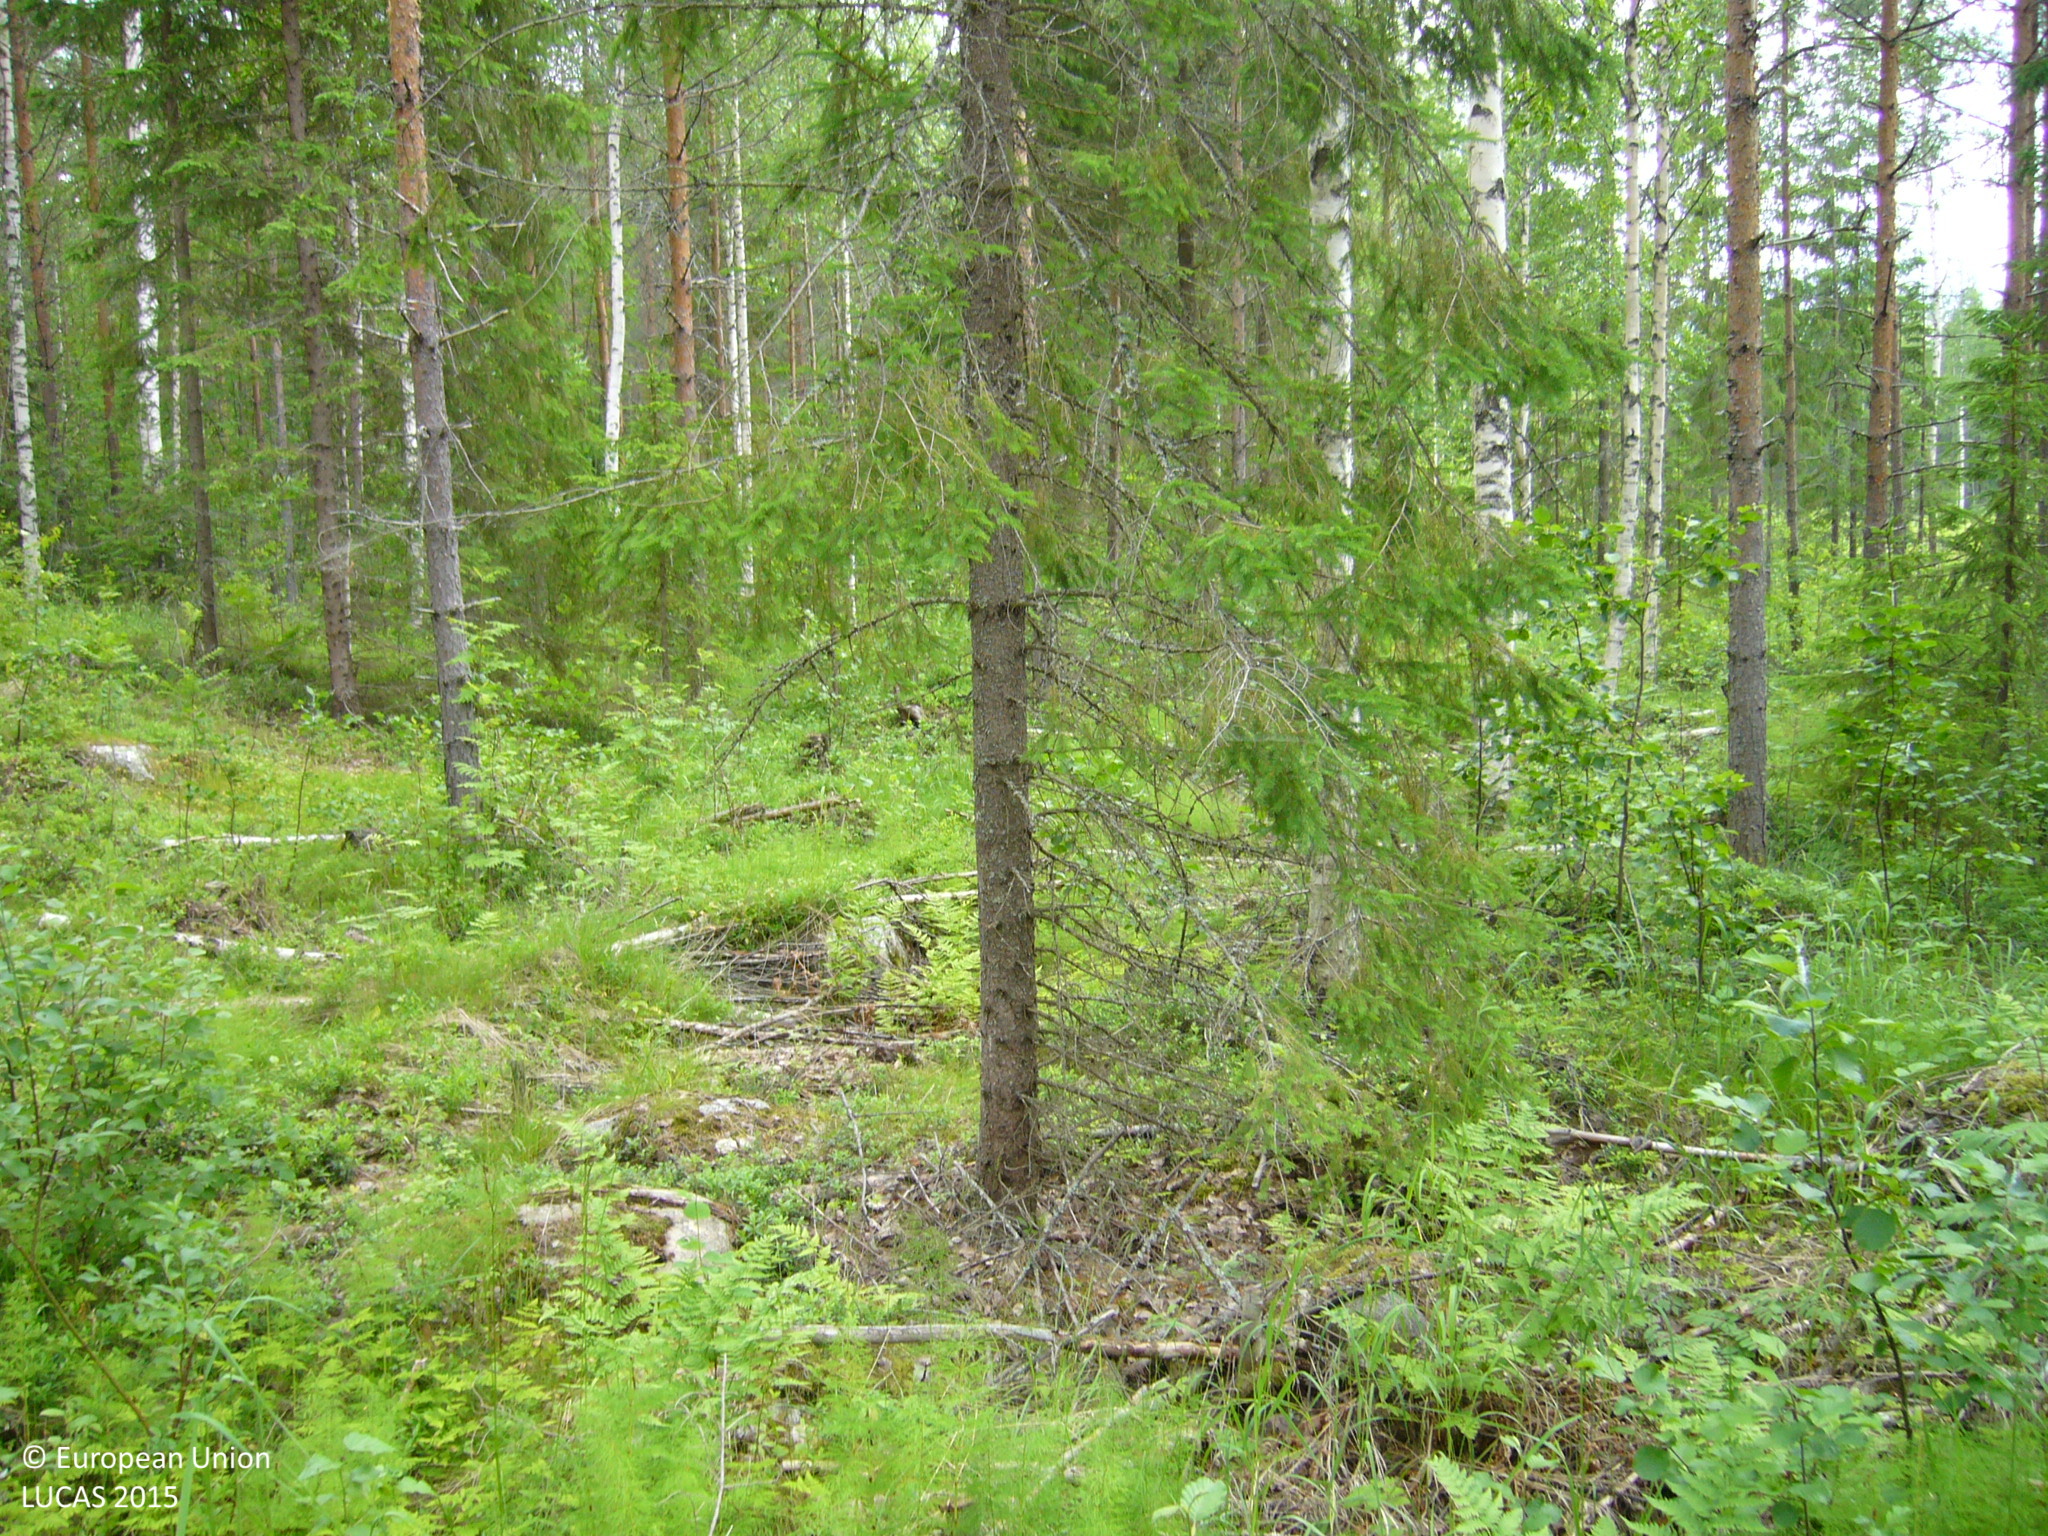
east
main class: Woodland
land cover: Pine dominated mixed woodland
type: boreal forest
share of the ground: > 75 %
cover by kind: coniferous forest trees 50 %, broadleaved forest trees 25 %, shrubs 25 %
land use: Forestry
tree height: > 5 m
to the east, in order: Pine dominated mixed woodland; Ditches and canals; Pine dominated mixed woodland; Other mixed woodland
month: July
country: FI
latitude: 63.1861
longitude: 26.0339
